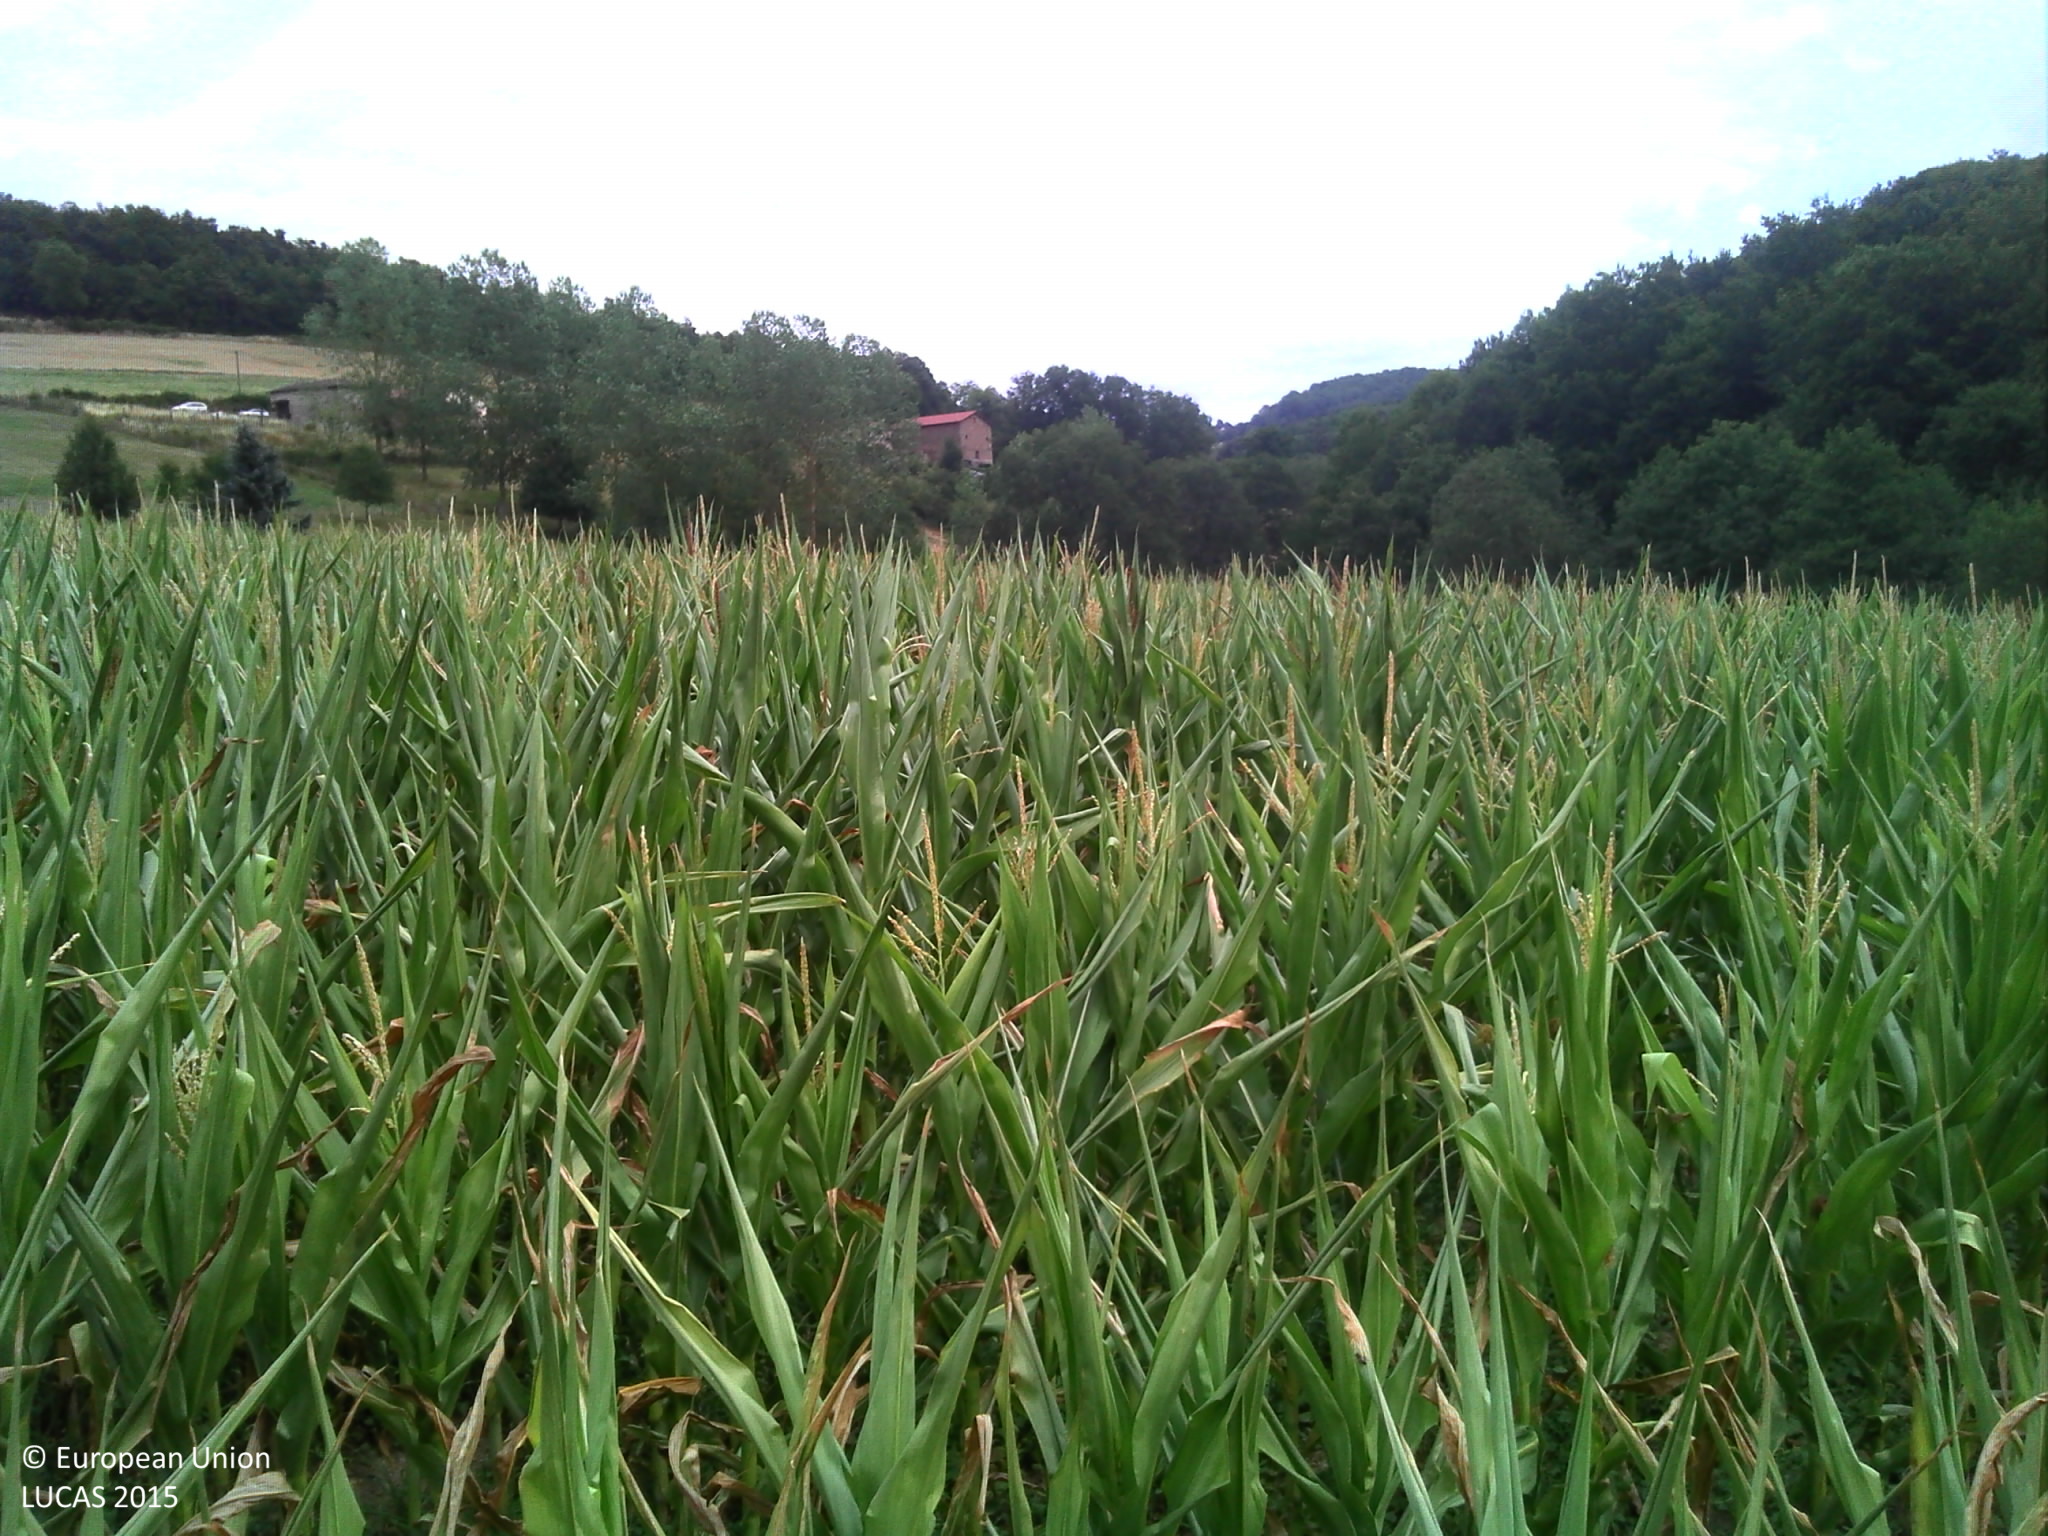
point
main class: Cropland
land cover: Maize
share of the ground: > 75 %
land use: Agriculture (excluding fallow land and kitchen gardens)
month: July
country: FR
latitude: 45.5947
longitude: 4.4785
